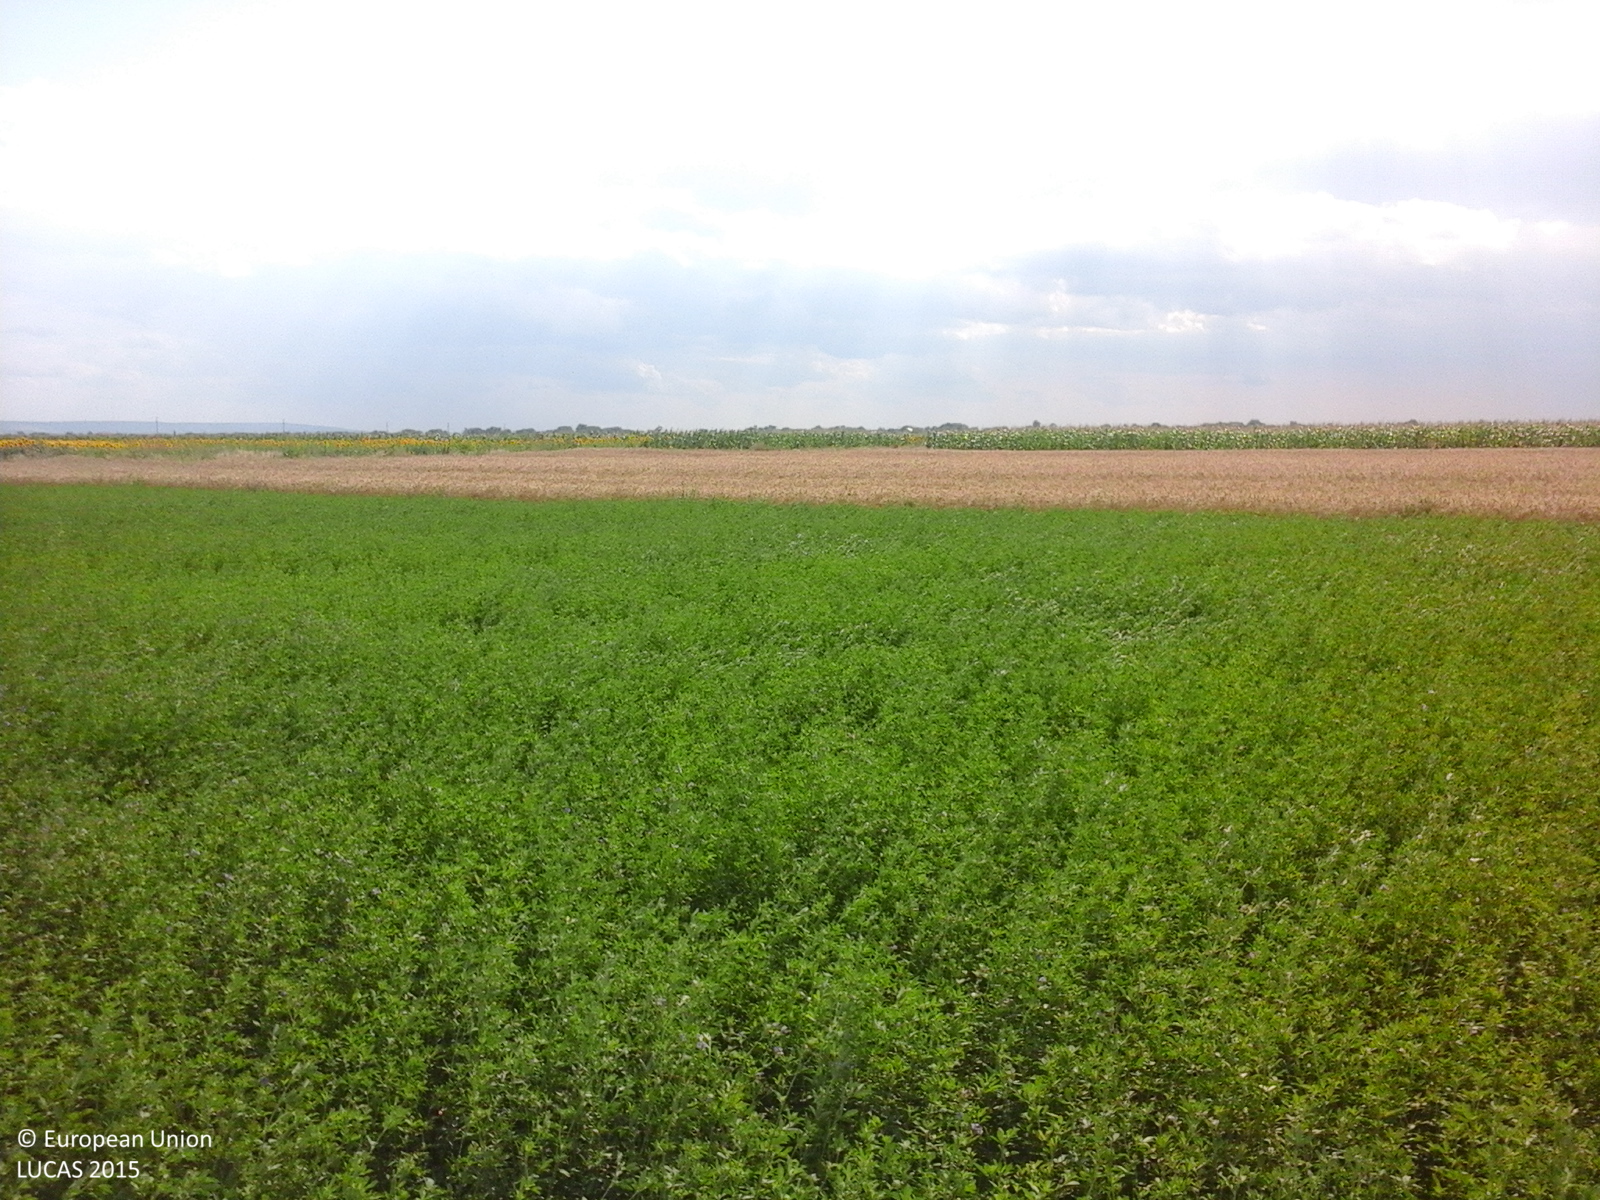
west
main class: Cropland
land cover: Lucerne
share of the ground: > 75 %
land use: Agriculture (excluding fallow land and kitchen gardens)
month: July
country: RO
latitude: 43.7700
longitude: 24.3353
